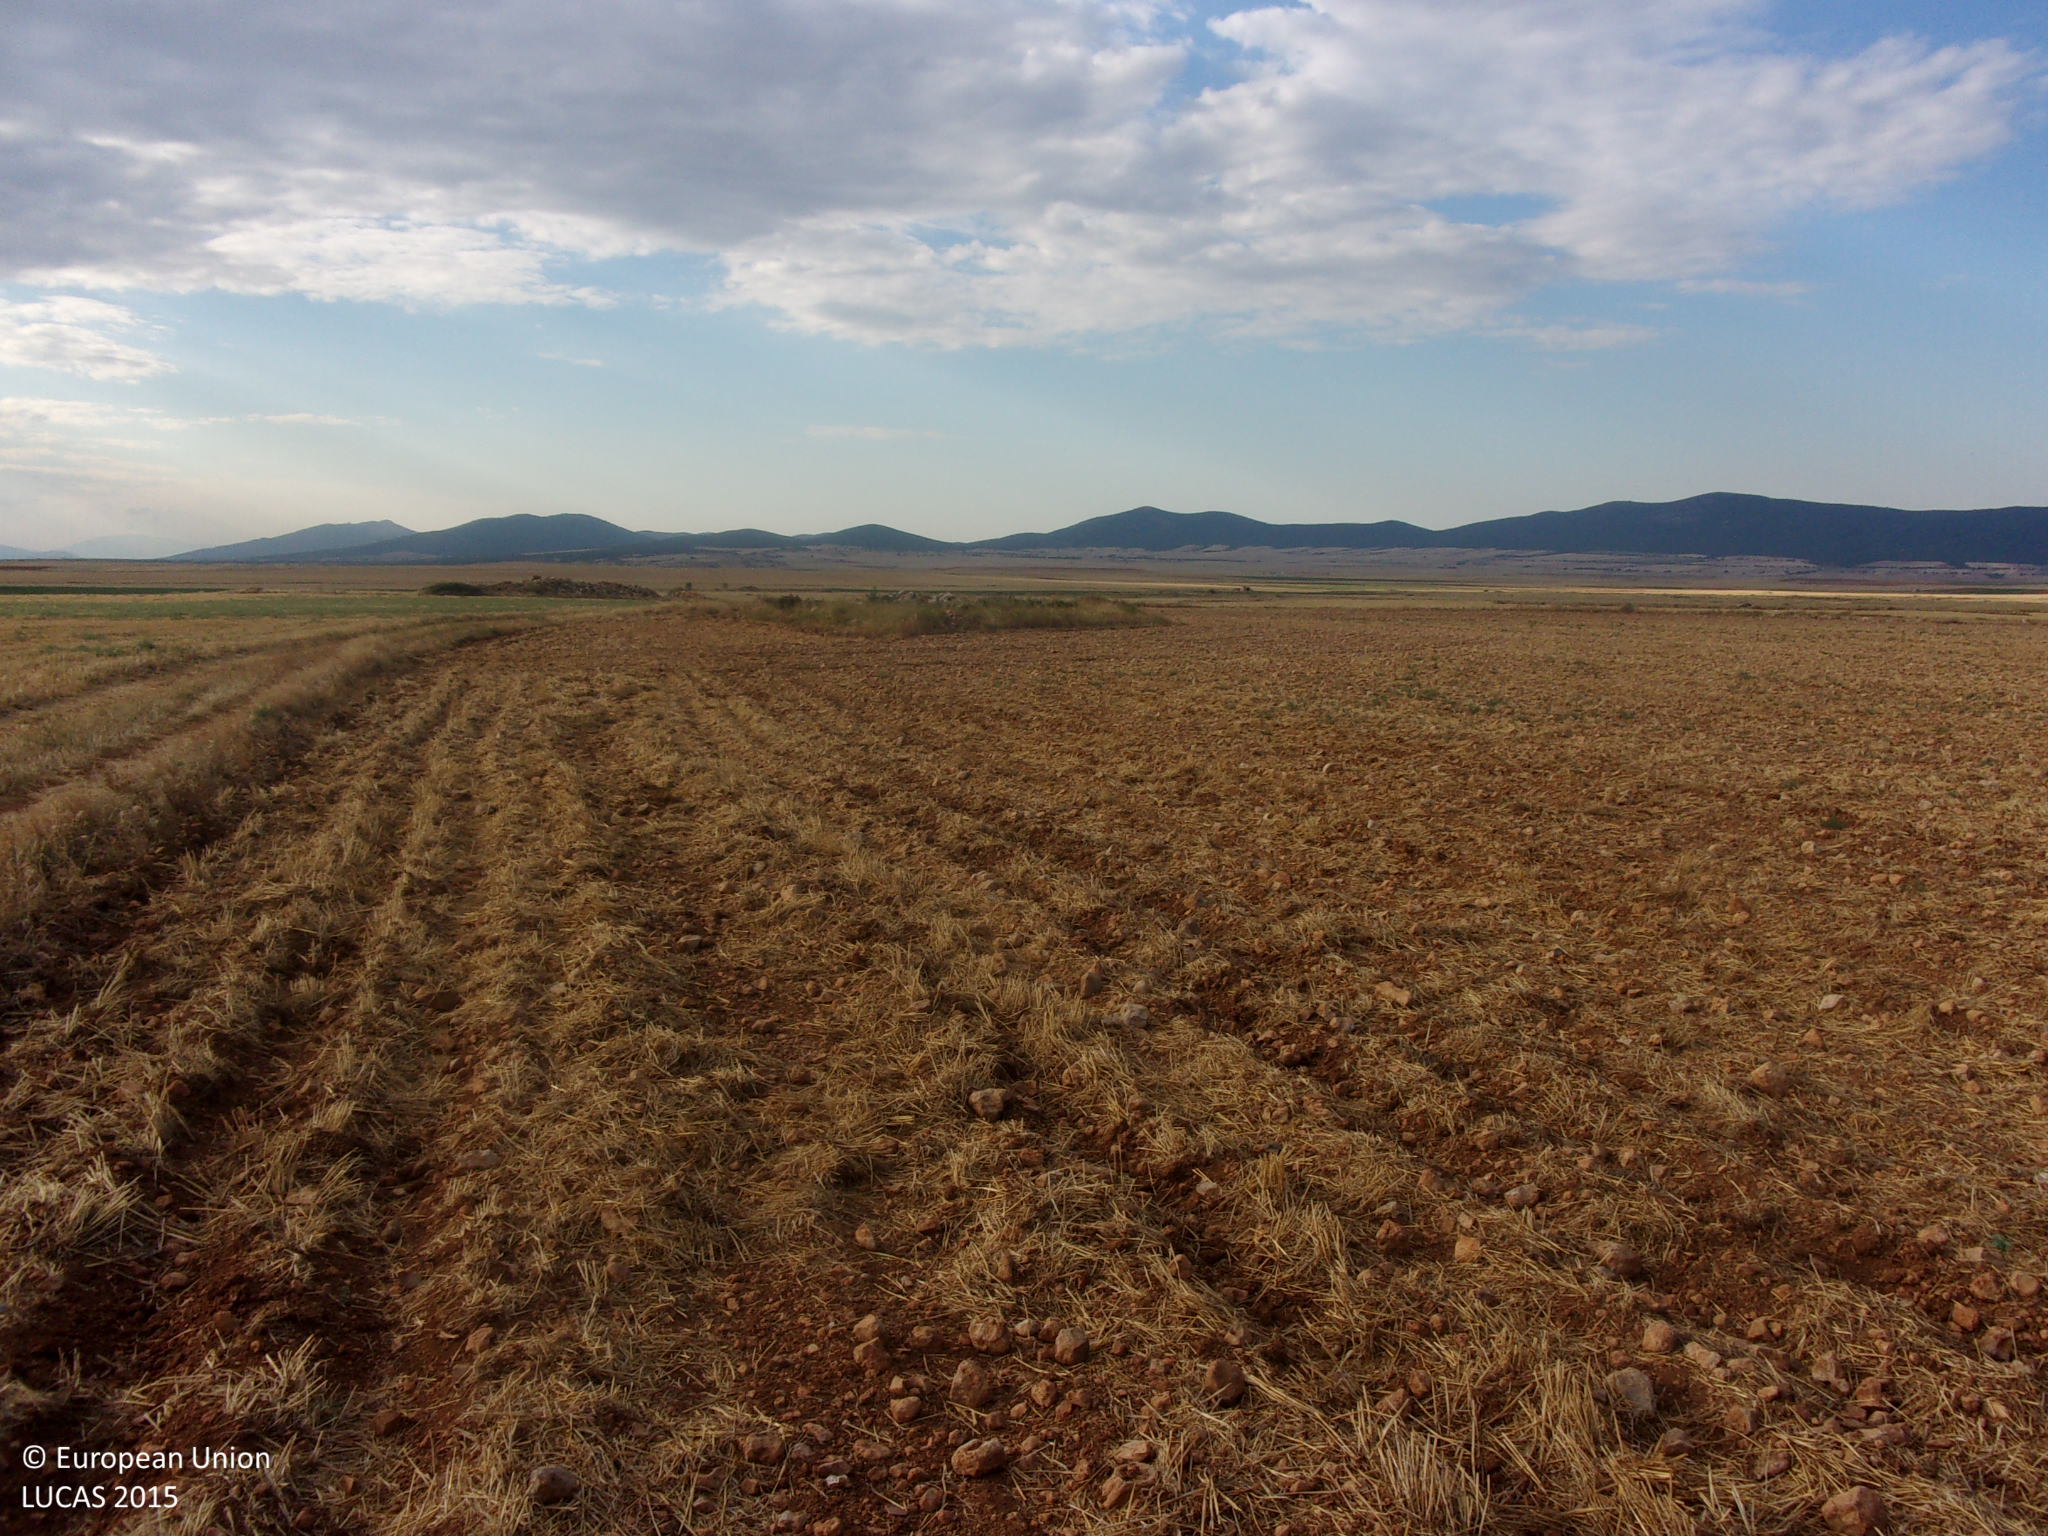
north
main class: Cropland
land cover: Barley
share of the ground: < 10 %
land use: Agriculture (excluding fallow land and kitchen gardens)
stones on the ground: < 10 %
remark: Harvested field
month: July
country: ES
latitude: 41.1720
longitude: -1.3805
